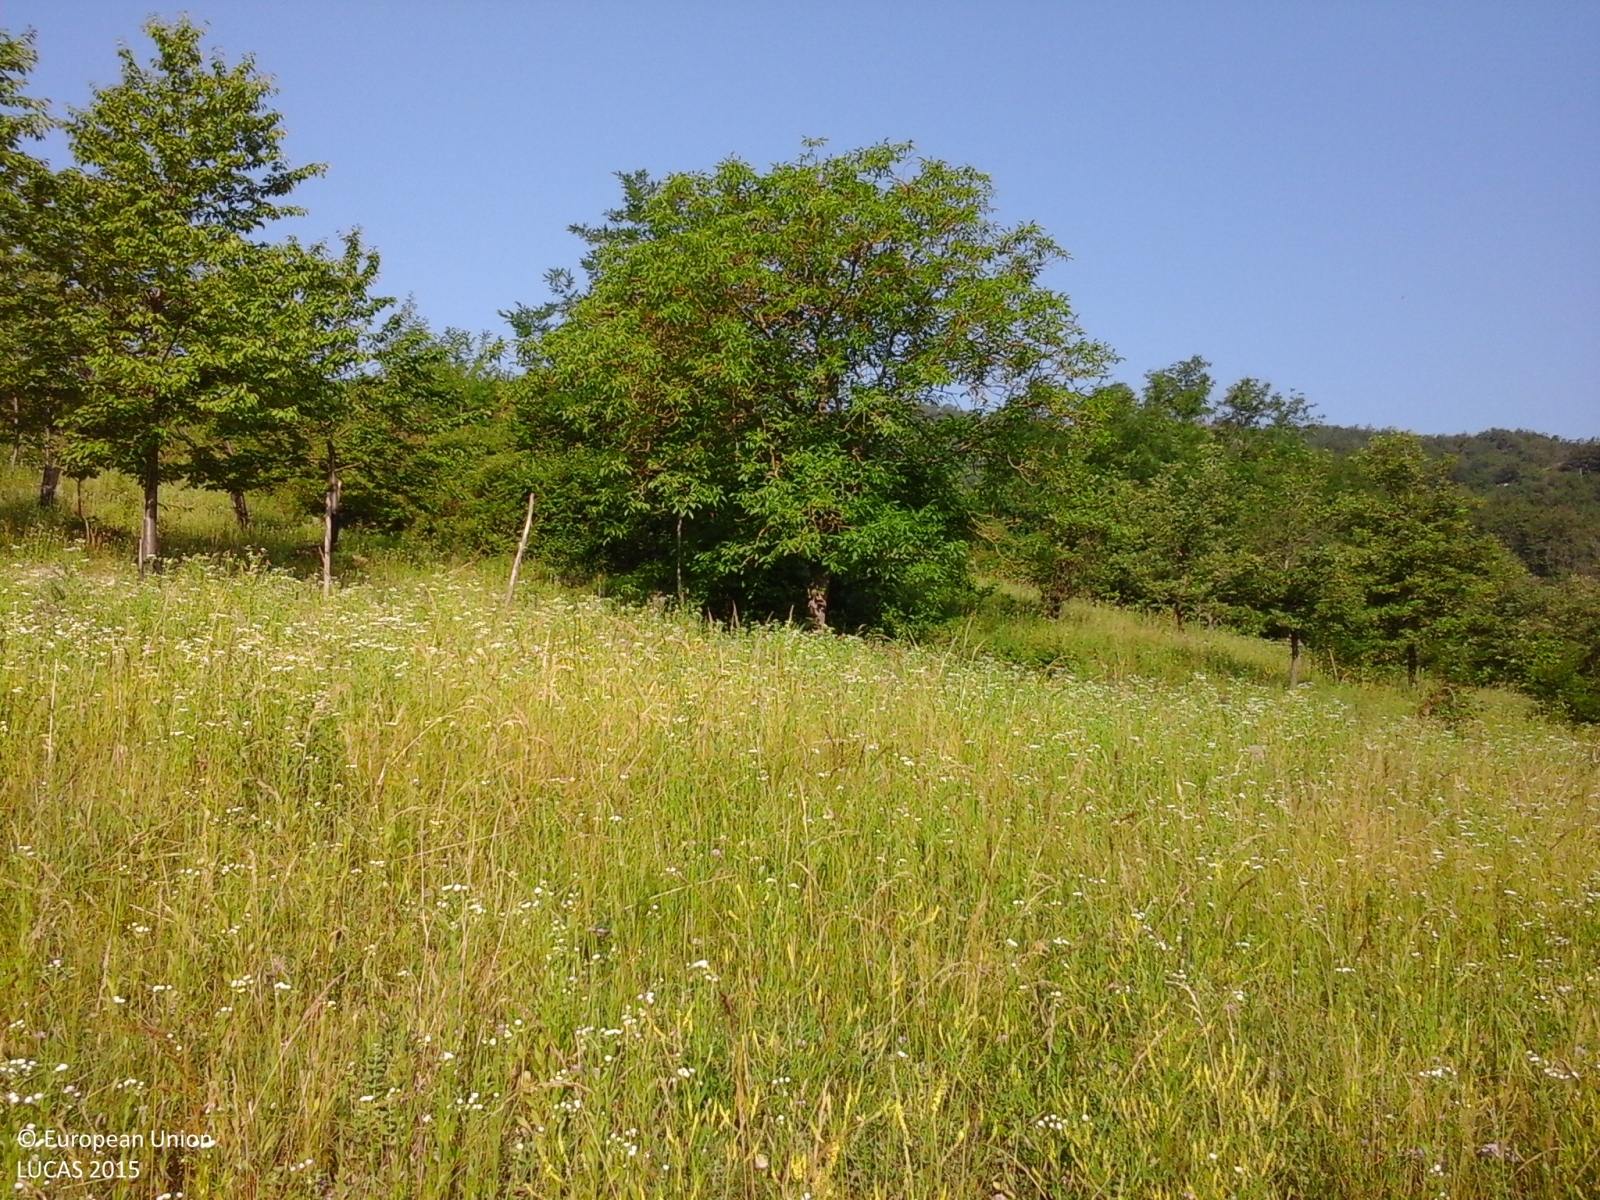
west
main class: Grassland
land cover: Grassland with sparse tree/shrub cover
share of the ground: > 75 %
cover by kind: herbaceous plants 90 %, broadleaved forest trees 5 %, shrubs 5 %
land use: Agriculture (excluding fallow land and kitchen gardens)
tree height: < 5 m
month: June
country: IT
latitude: 44.6088
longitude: 8.4031
